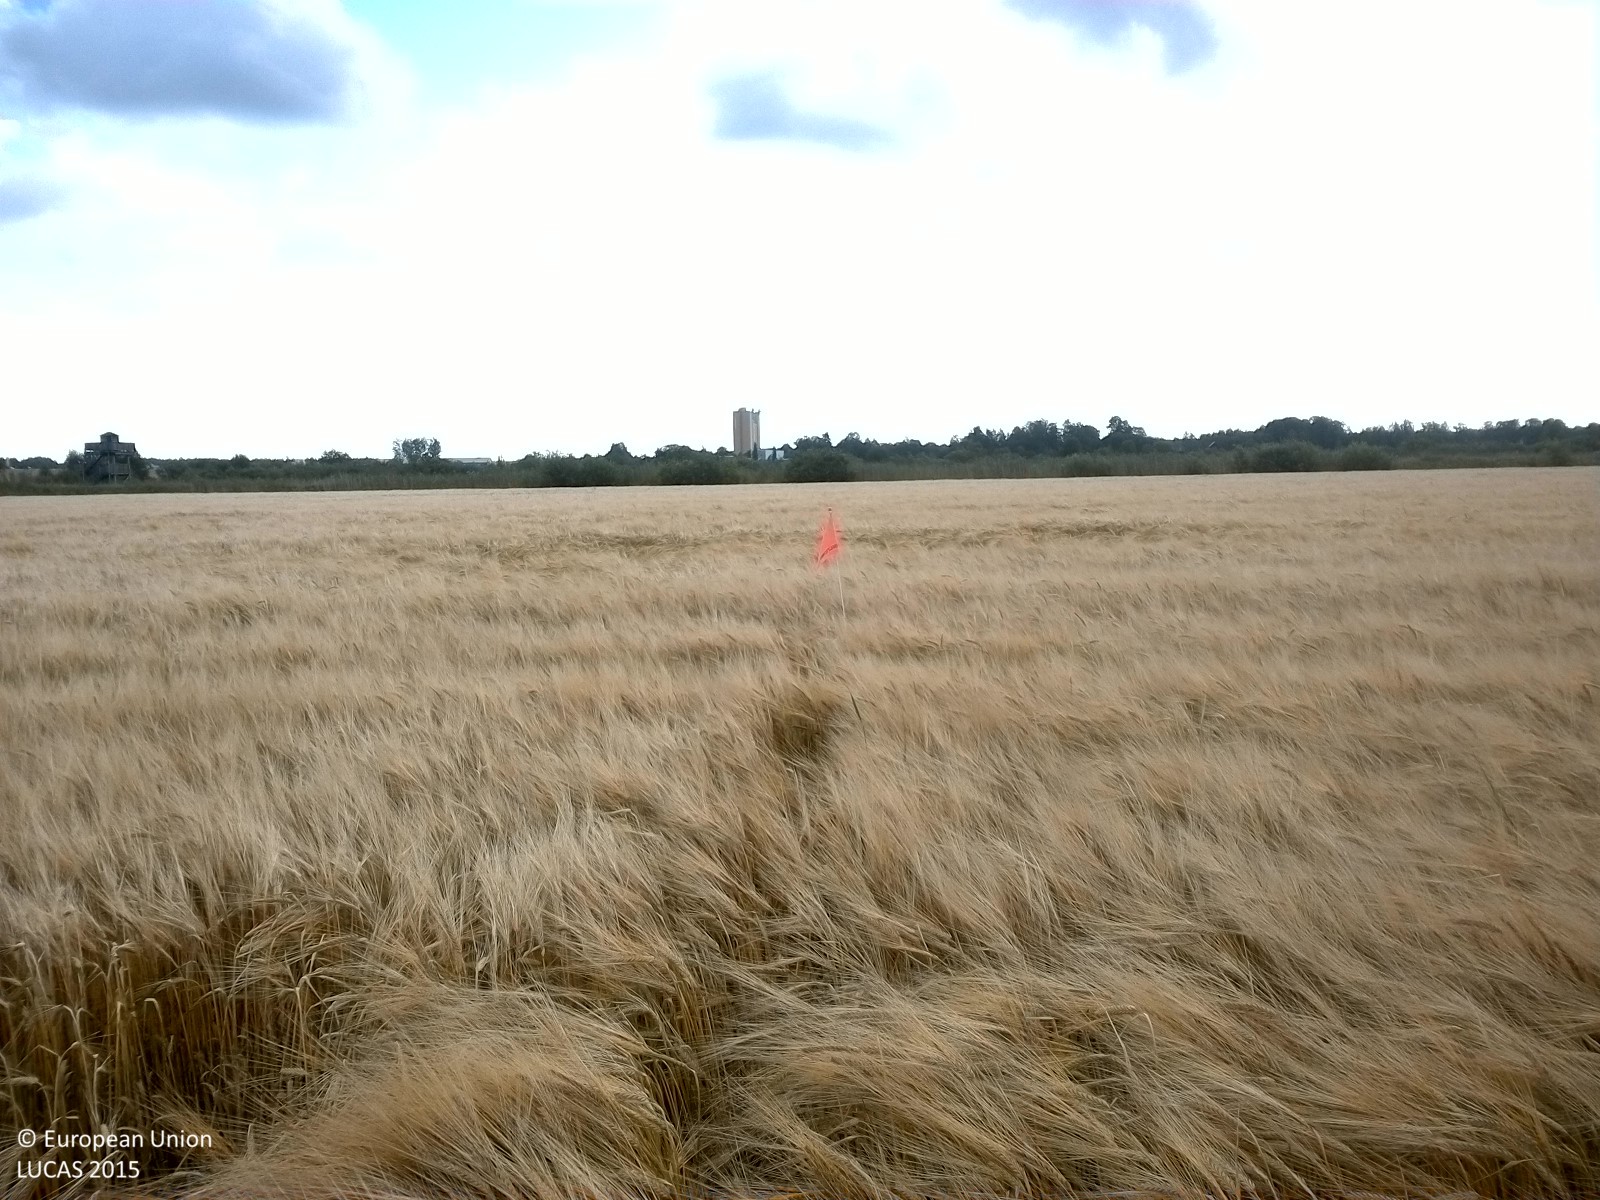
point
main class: Cropland
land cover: Barley
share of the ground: > 75 %
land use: Agriculture (excluding fallow land and kitchen gardens)
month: August
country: SE
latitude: 59.1141
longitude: 15.1094
